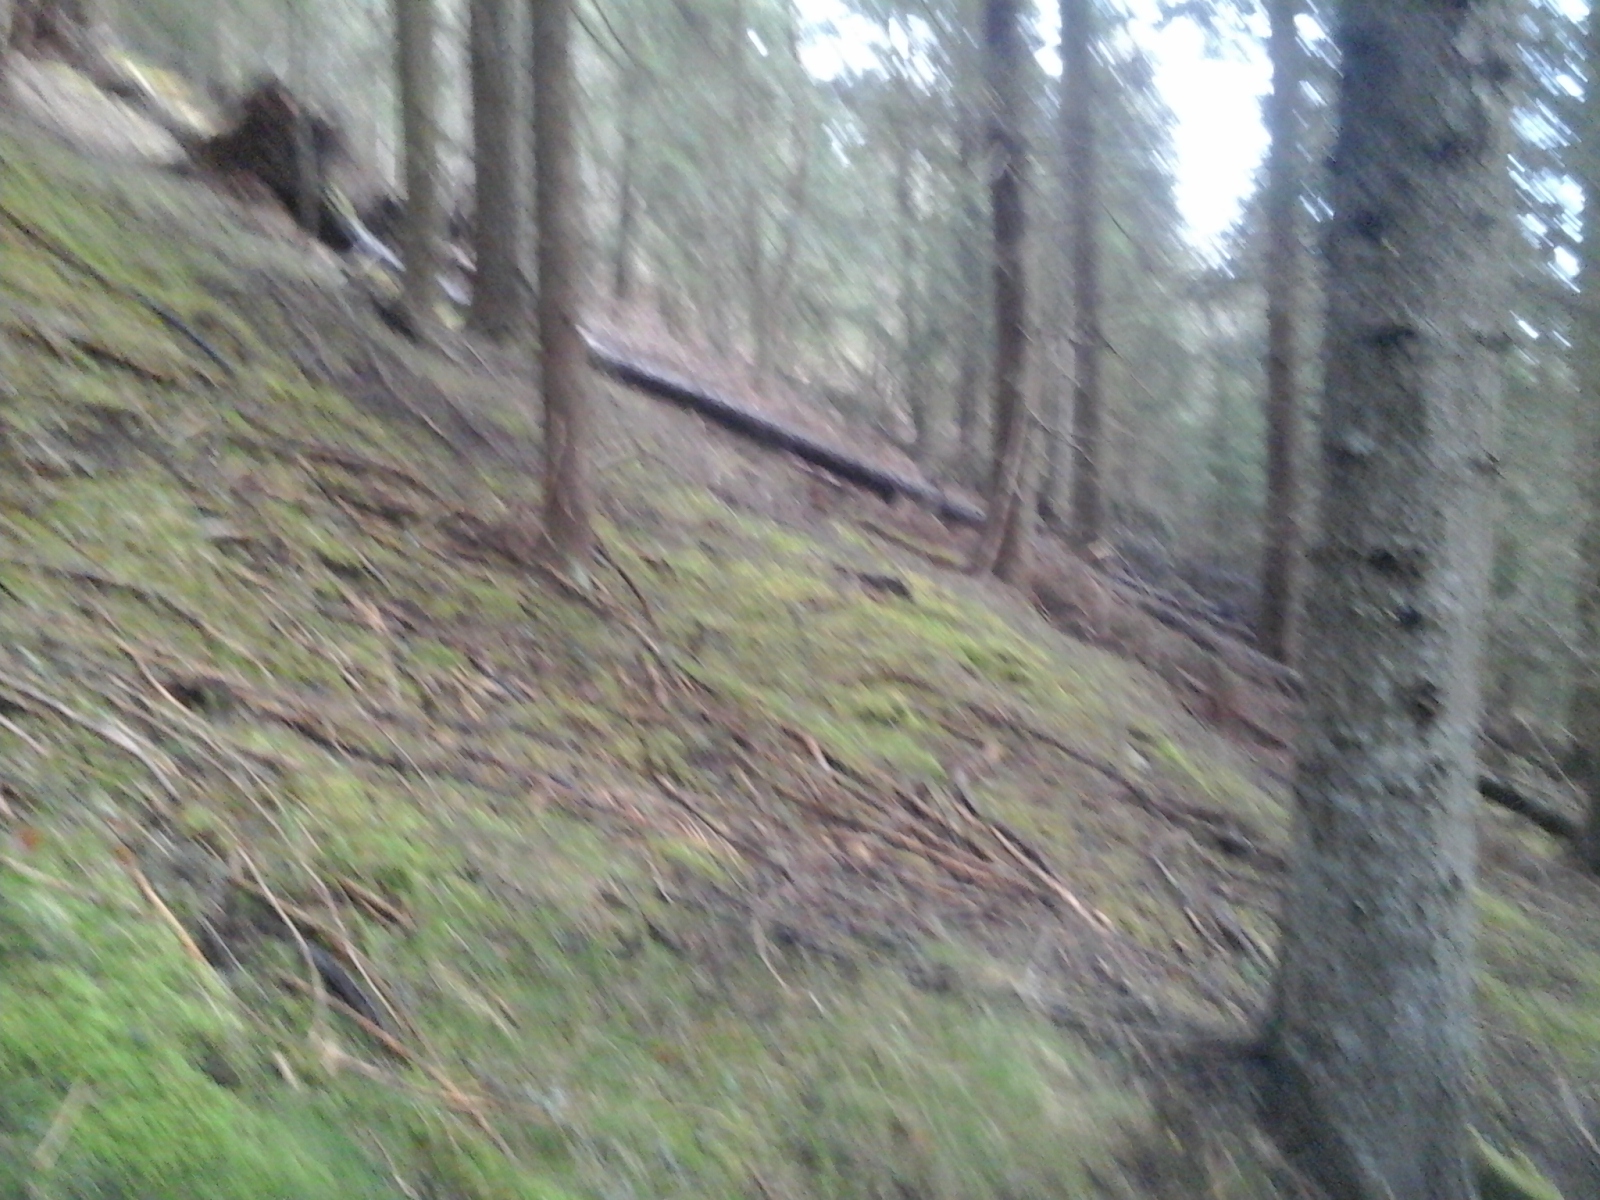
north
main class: Woodland
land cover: Spruce dominated coniferous woodland
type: alpine coniferous forest
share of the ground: > 75 %
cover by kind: coniferous forest trees 95 %, lichens and mosses 5 %
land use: Forestry
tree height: > 5 m
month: May
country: IT
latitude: 46.3807
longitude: 11.1816
